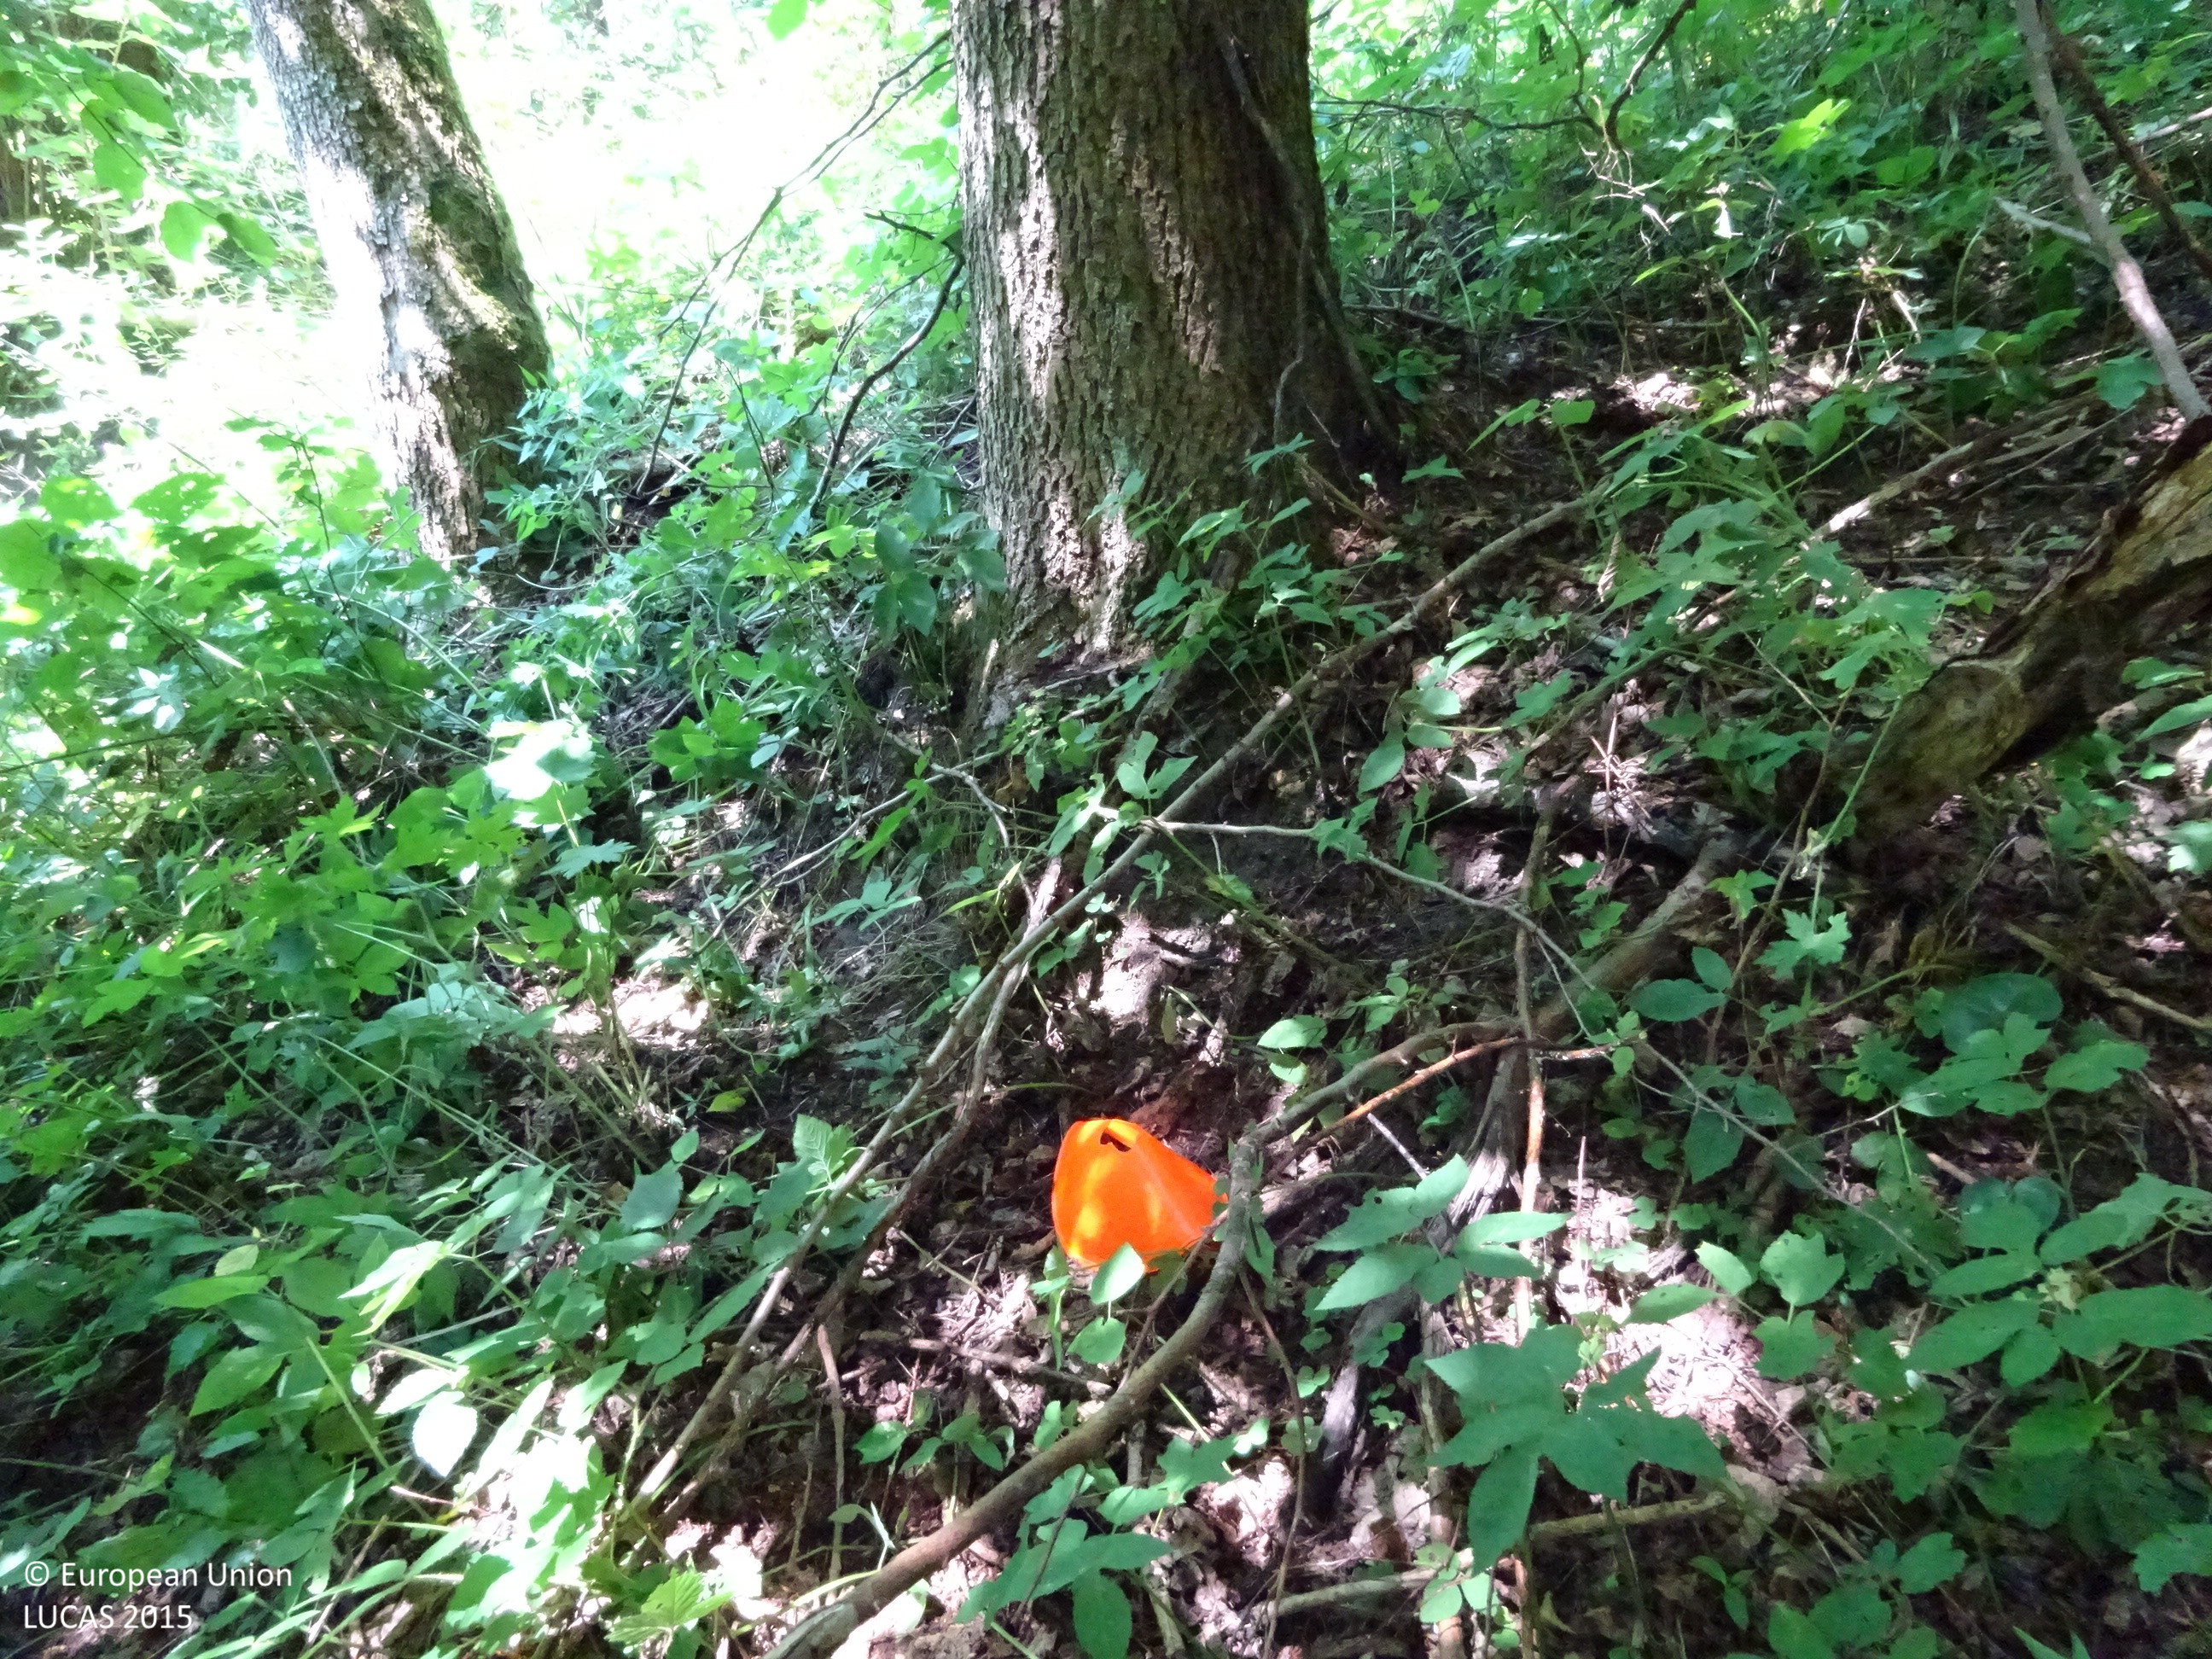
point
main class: Woodland
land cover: Spruce dominated mixed woodland
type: mountainous beech forest
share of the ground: > 75 %
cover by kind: broadleaved forest trees 45 %, coniferous forest trees 25 %, shrubs 20 %, unconsolidated bare surface 10 %
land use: Forestry
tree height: > 5 m
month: August
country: AT
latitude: 47.4280
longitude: 15.3165
